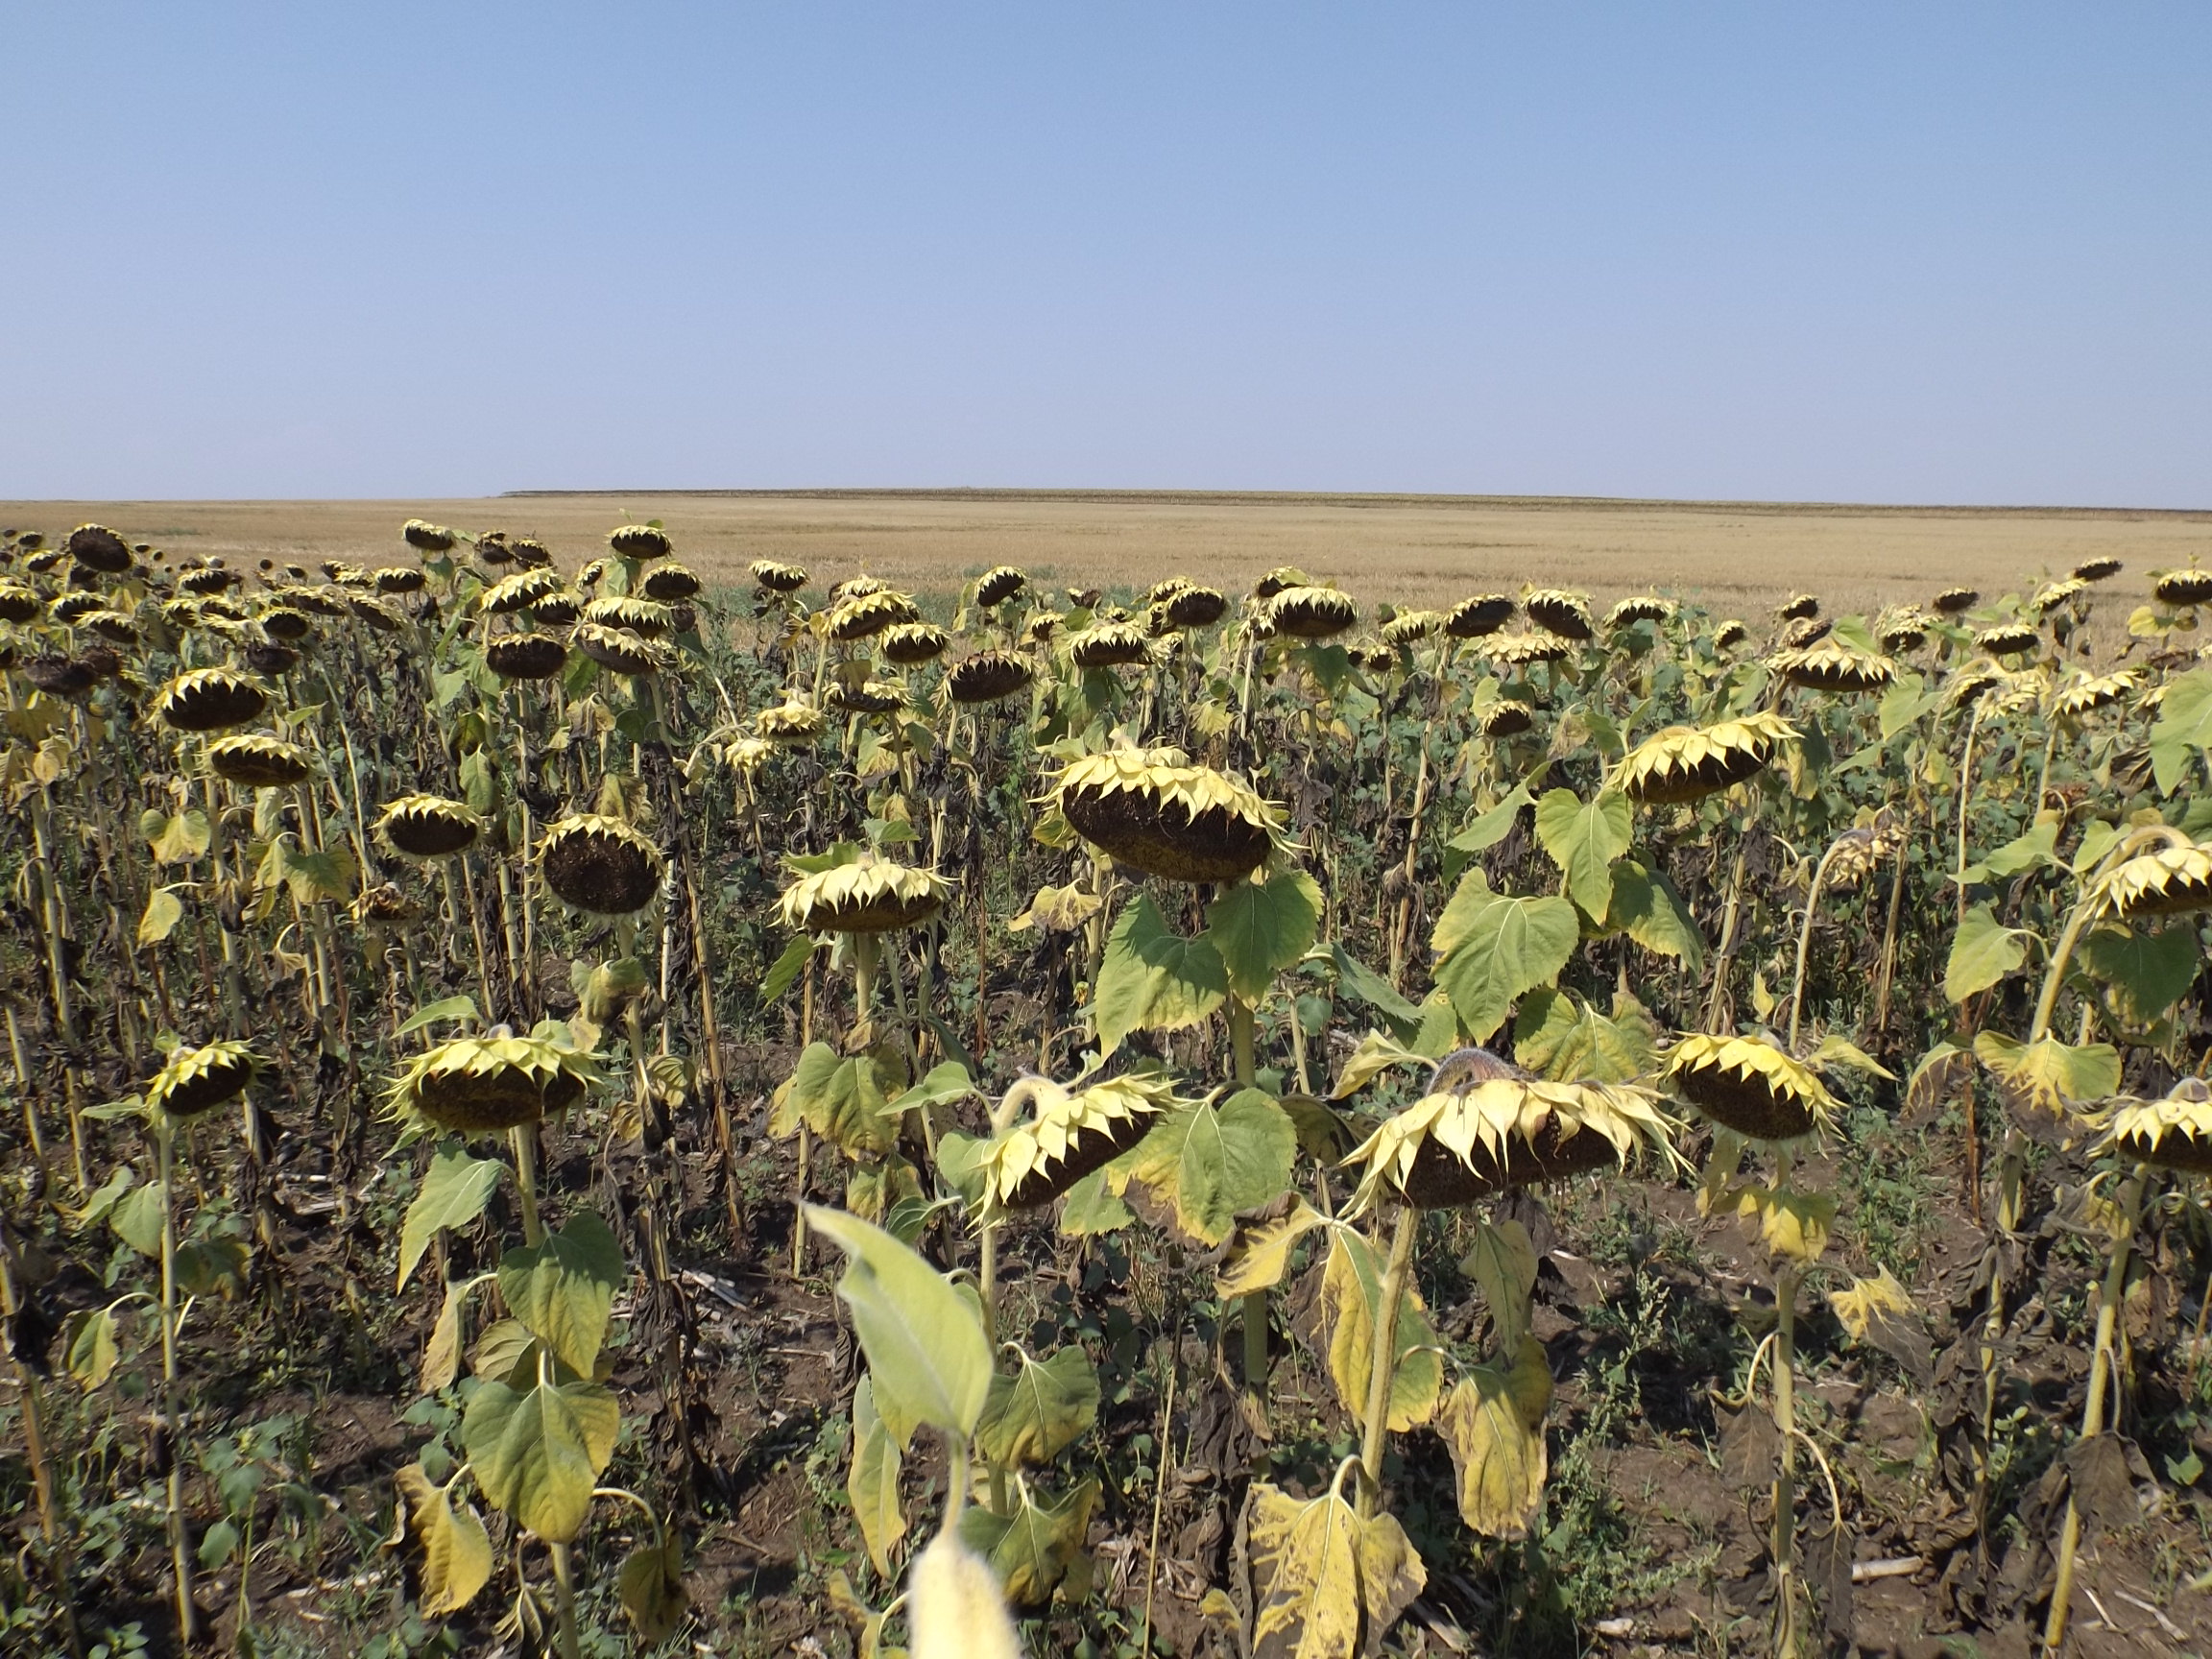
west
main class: Cropland
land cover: Sunflower
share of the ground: 50 - 75 %
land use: Agriculture (excluding fallow land and kitchen gardens)
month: August
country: BG
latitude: 43.2748
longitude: 27.4893
